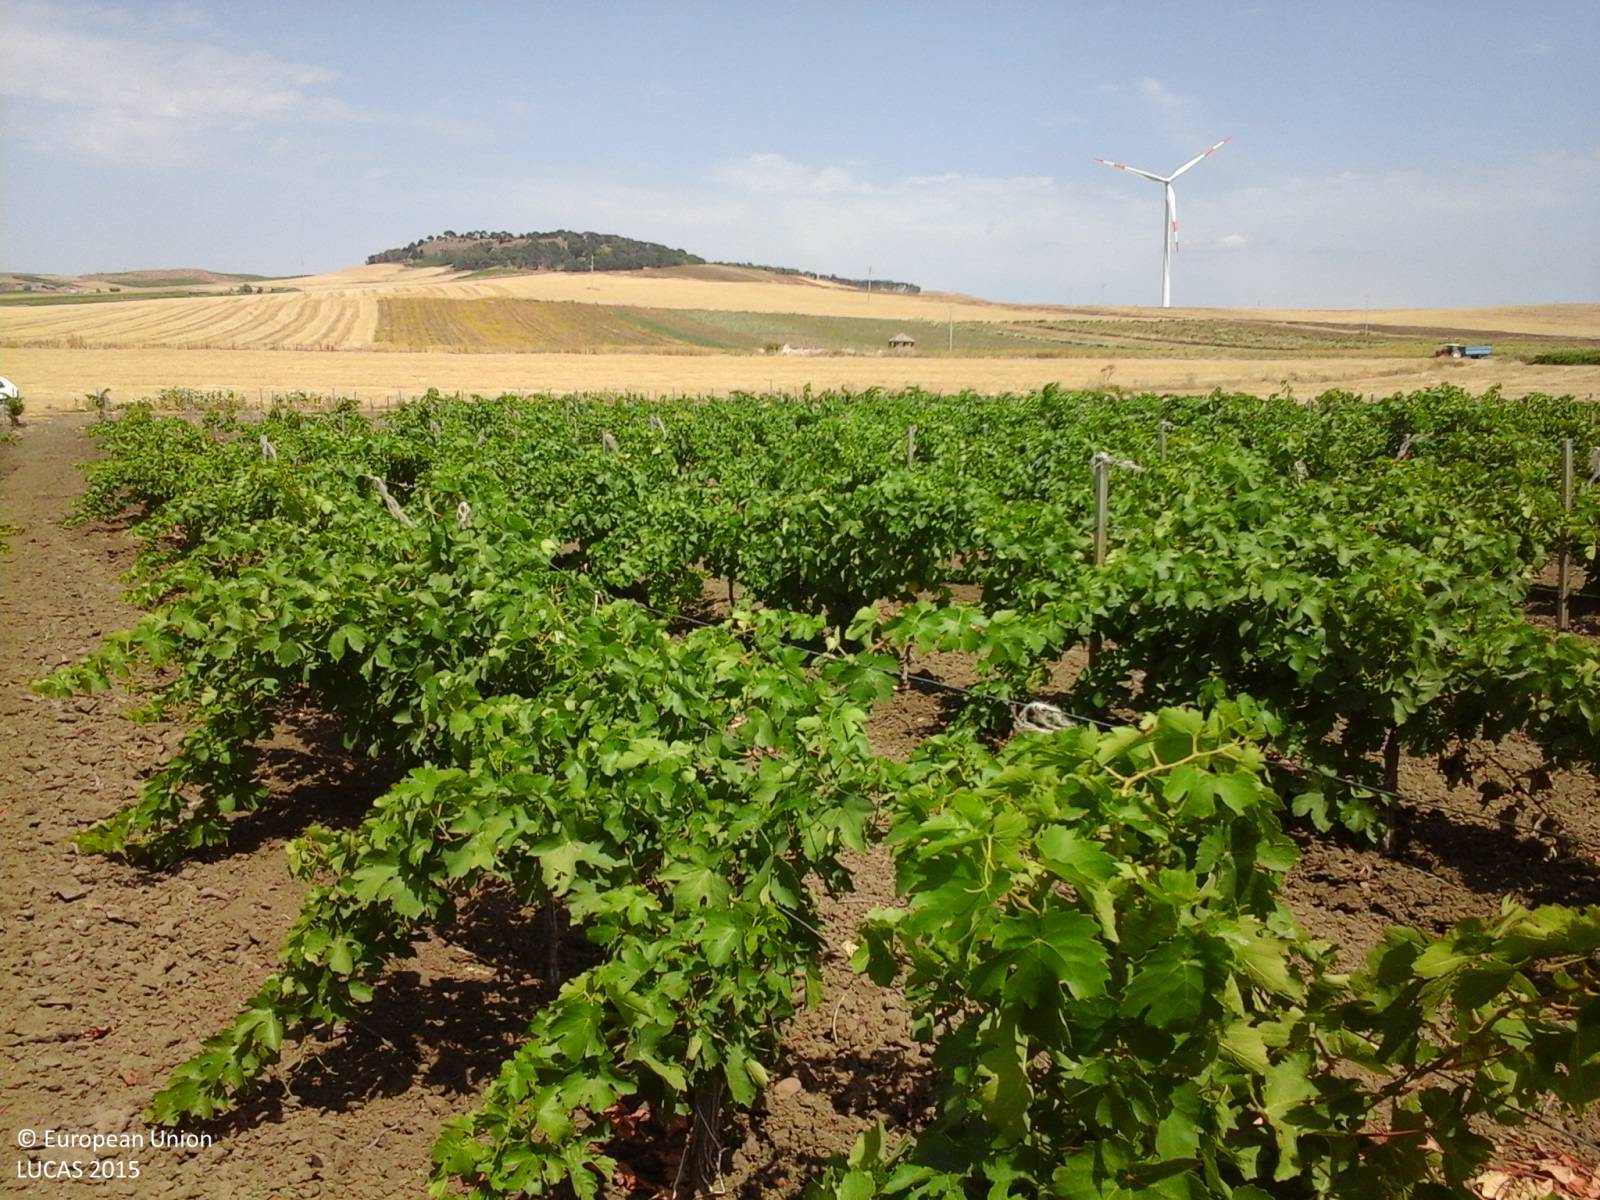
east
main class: Cropland
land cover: Vineyards
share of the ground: 50 - 75 %
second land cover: Other bare soil
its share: > 75 %
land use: Agriculture (excluding fallow land and kitchen gardens)
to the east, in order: Vineyards; Other bare soil; Grass margins; Tracks; Grass margins; Durum wheat; Grass margins; Paved roads, cycling and walking lanes; Grass margins; Single bushes/trees; Spontaneously vegetated surfaces; Artificial constructions in urban areas; Spontaneously vegetated surfaces
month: June
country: IT
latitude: 37.8559
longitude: 12.6513
